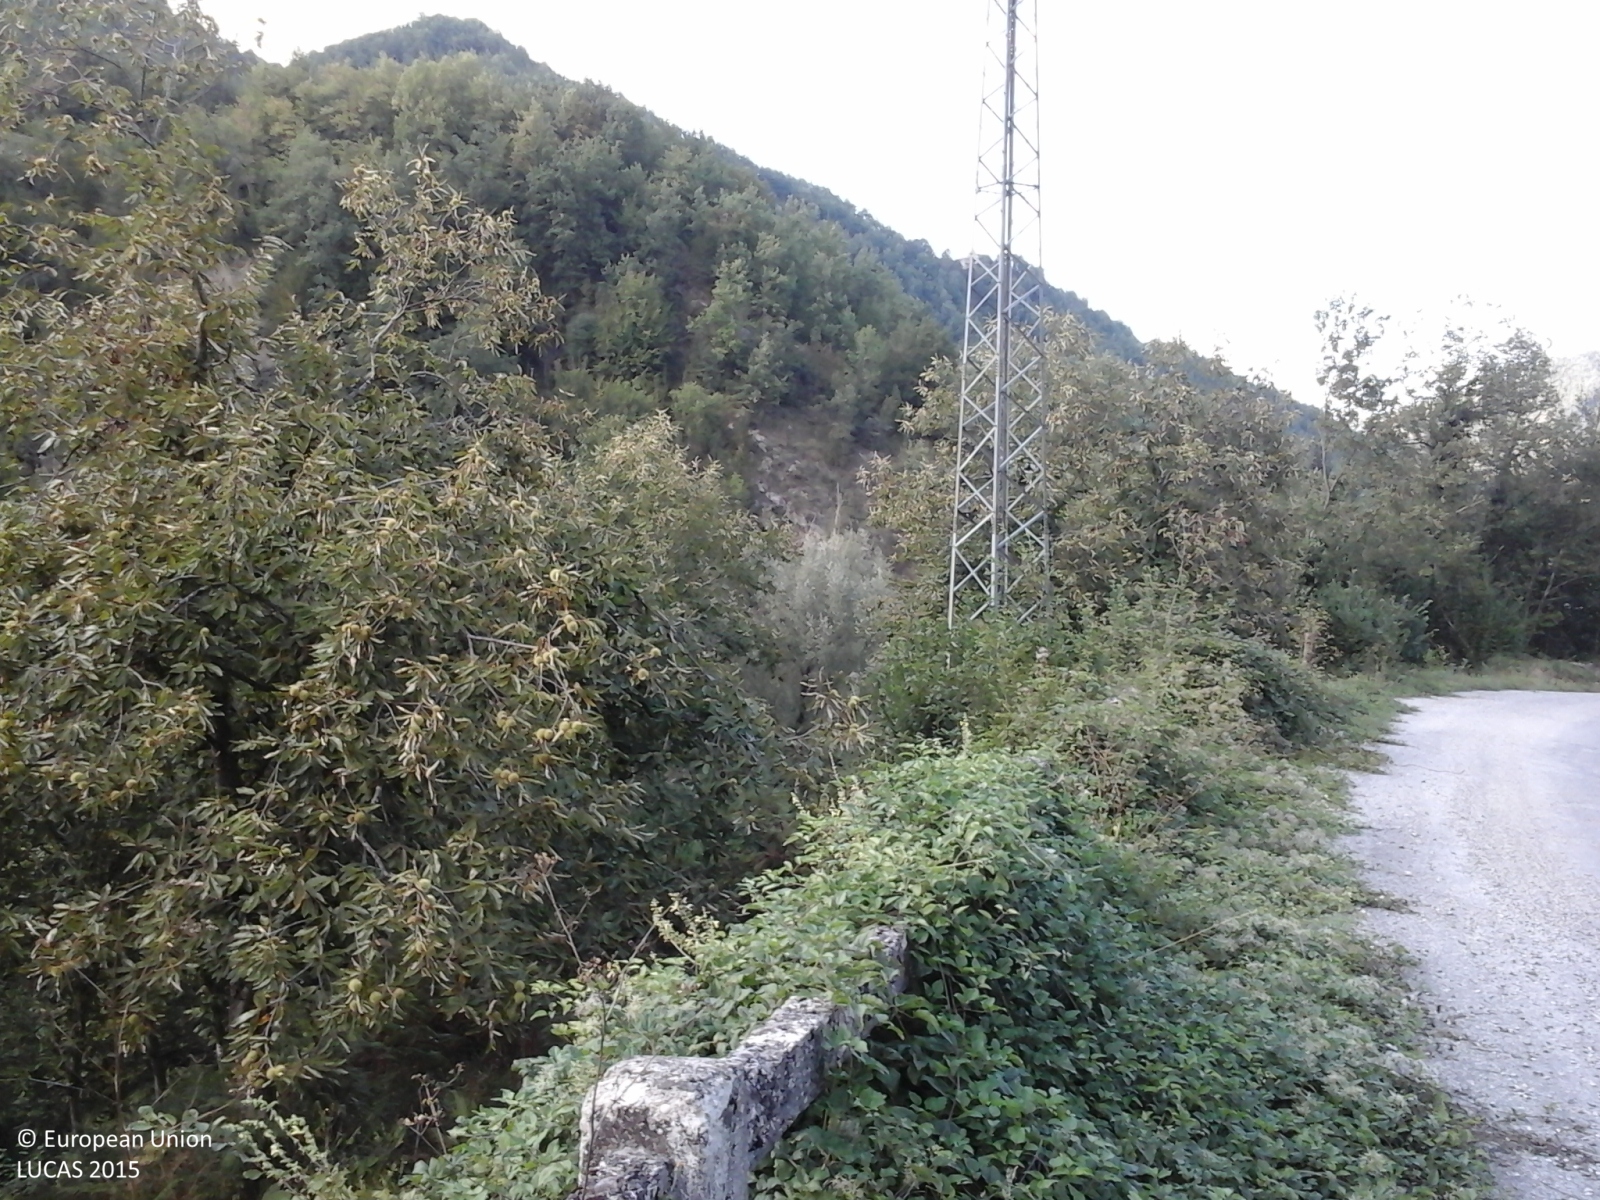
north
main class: Woodland
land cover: Other mixed woodland
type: thermophilous deciduous forest
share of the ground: > 75 %
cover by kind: coniferous forest trees 40 %, broadleaved forest trees 40 %, shrubs 10 %, herbaceous plants 10 %
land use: Semi-natural and natural areas not in use
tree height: > 5 m
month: September
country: IT
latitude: 42.7383
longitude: 13.4955
